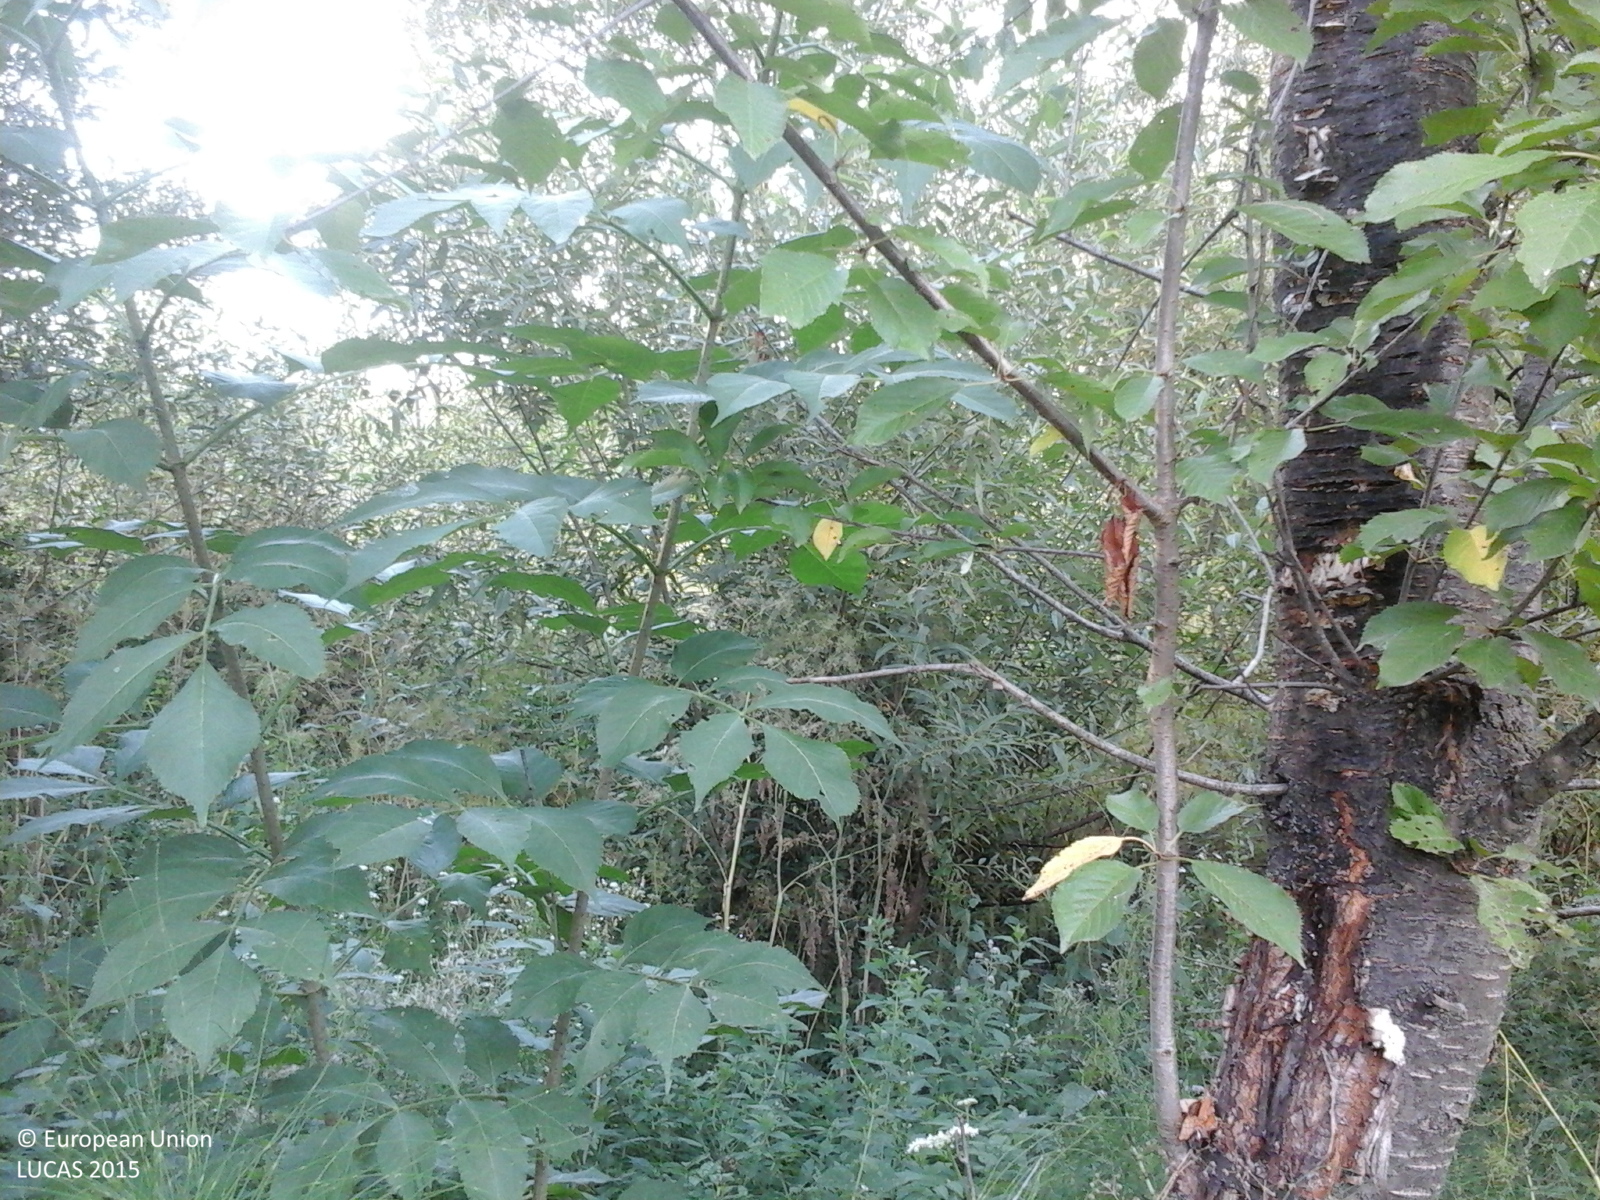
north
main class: Shrubland
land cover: Shrubland with sparse tree cover
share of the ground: > 75 %
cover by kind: shrubs 85 %, herbaceous plants 10 %, broadleaved forest trees 5 %
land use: Fallow land
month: July
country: RO
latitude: 46.2194
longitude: 26.8251
